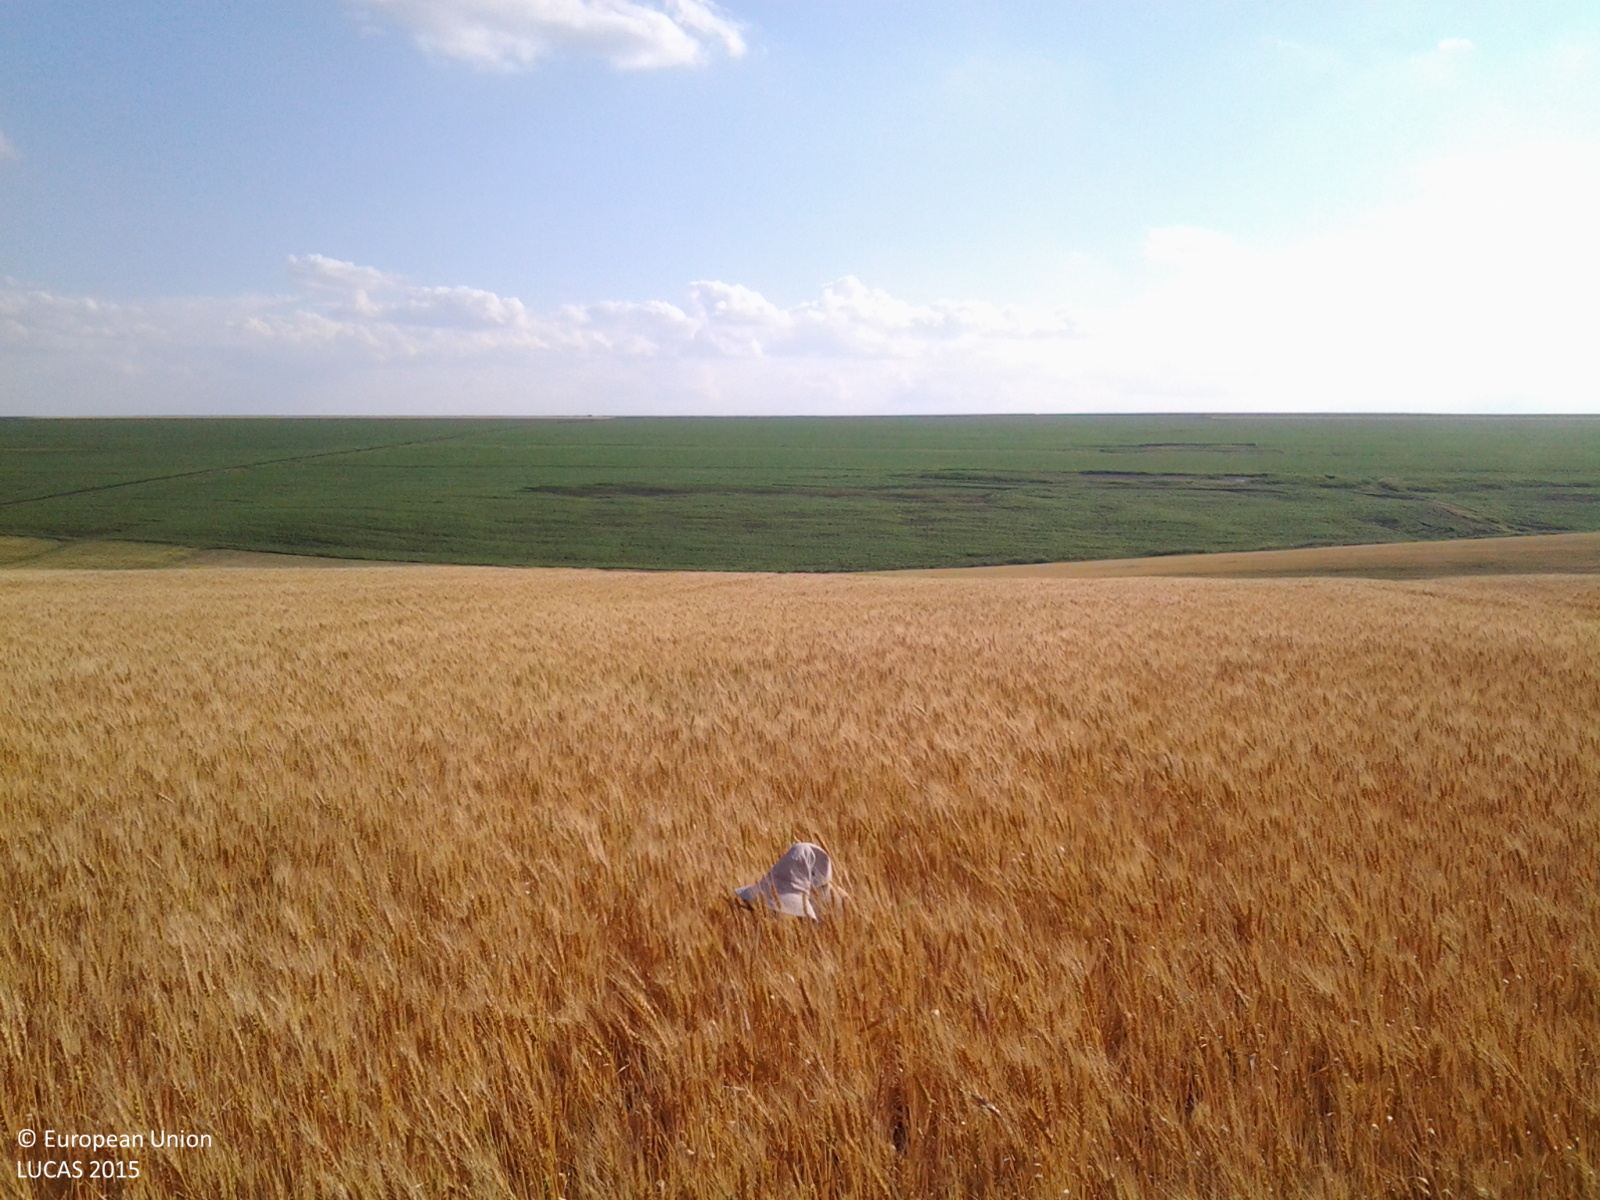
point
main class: Cropland
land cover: Common wheat
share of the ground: > 75 %
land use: Agriculture (excluding fallow land and kitchen gardens)
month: June
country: RO
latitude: 47.5665
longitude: 27.0250
